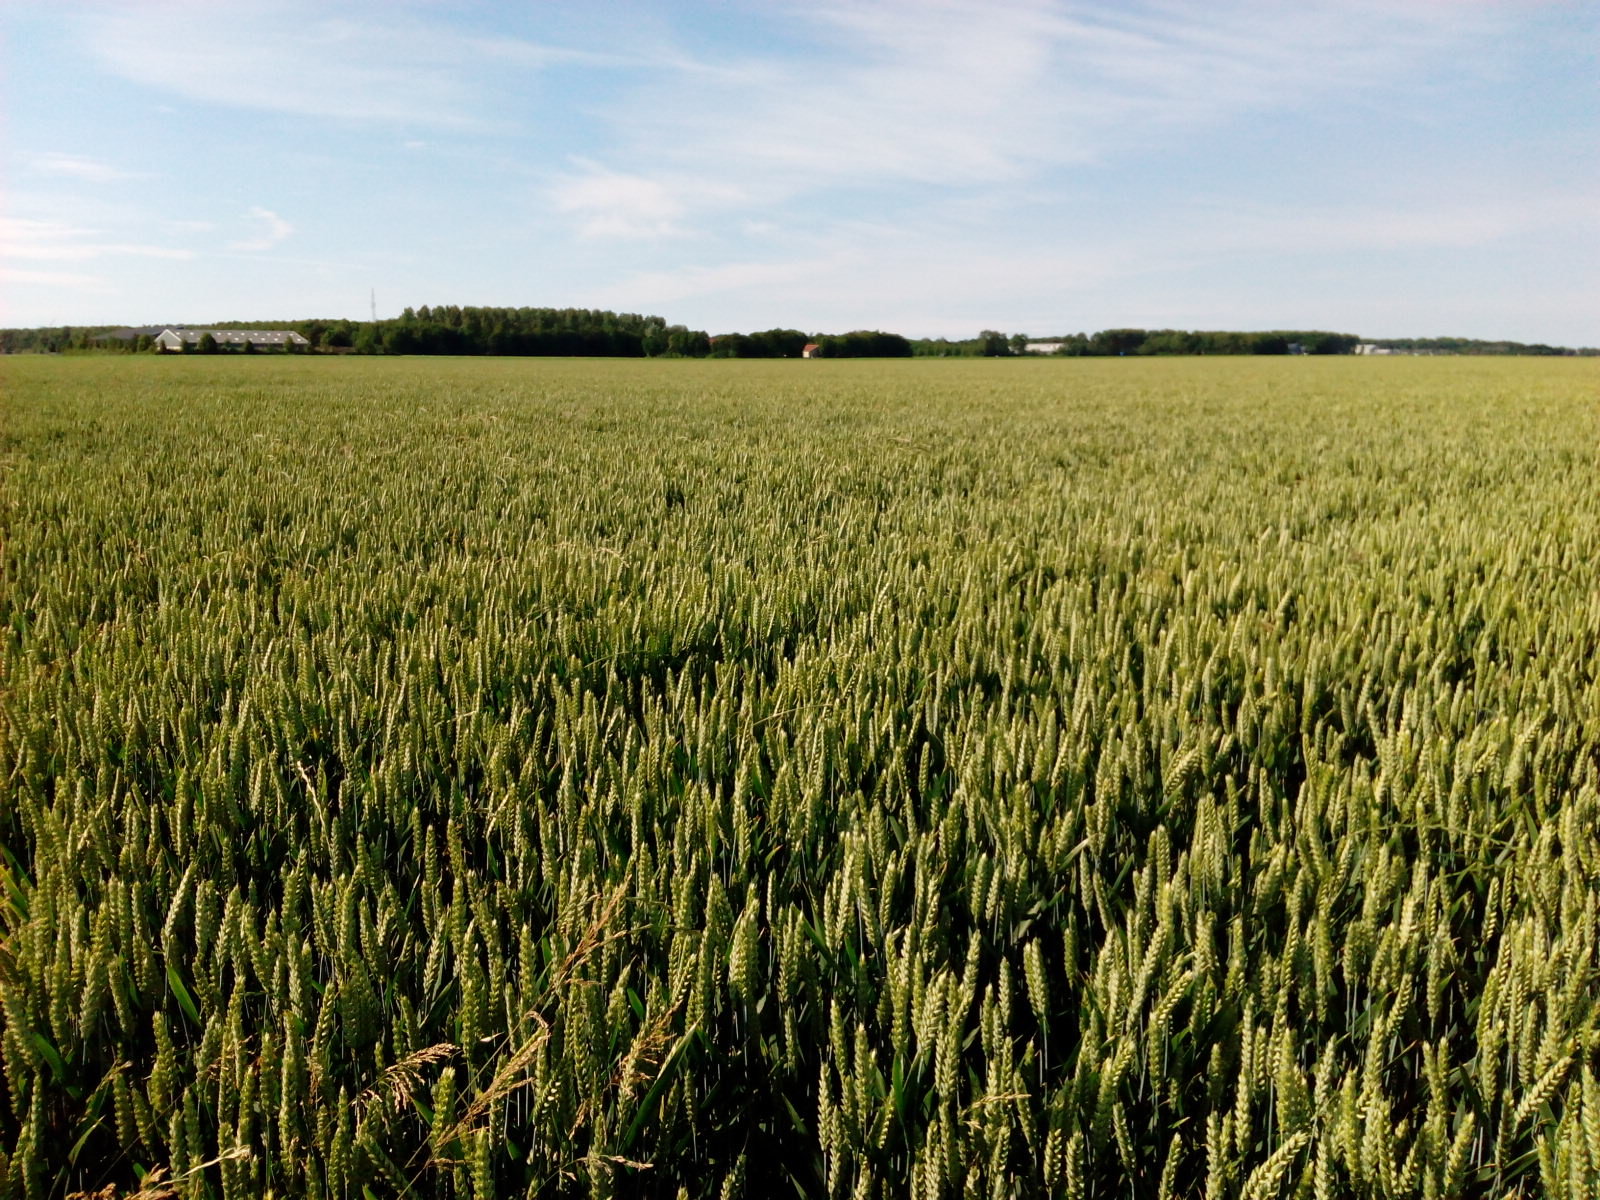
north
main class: Cropland
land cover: Common wheat
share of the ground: > 75 %
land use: Agriculture (excluding fallow land and kitchen gardens)
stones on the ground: < 10 %
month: June
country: NL
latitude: 52.5498
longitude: 5.6482
